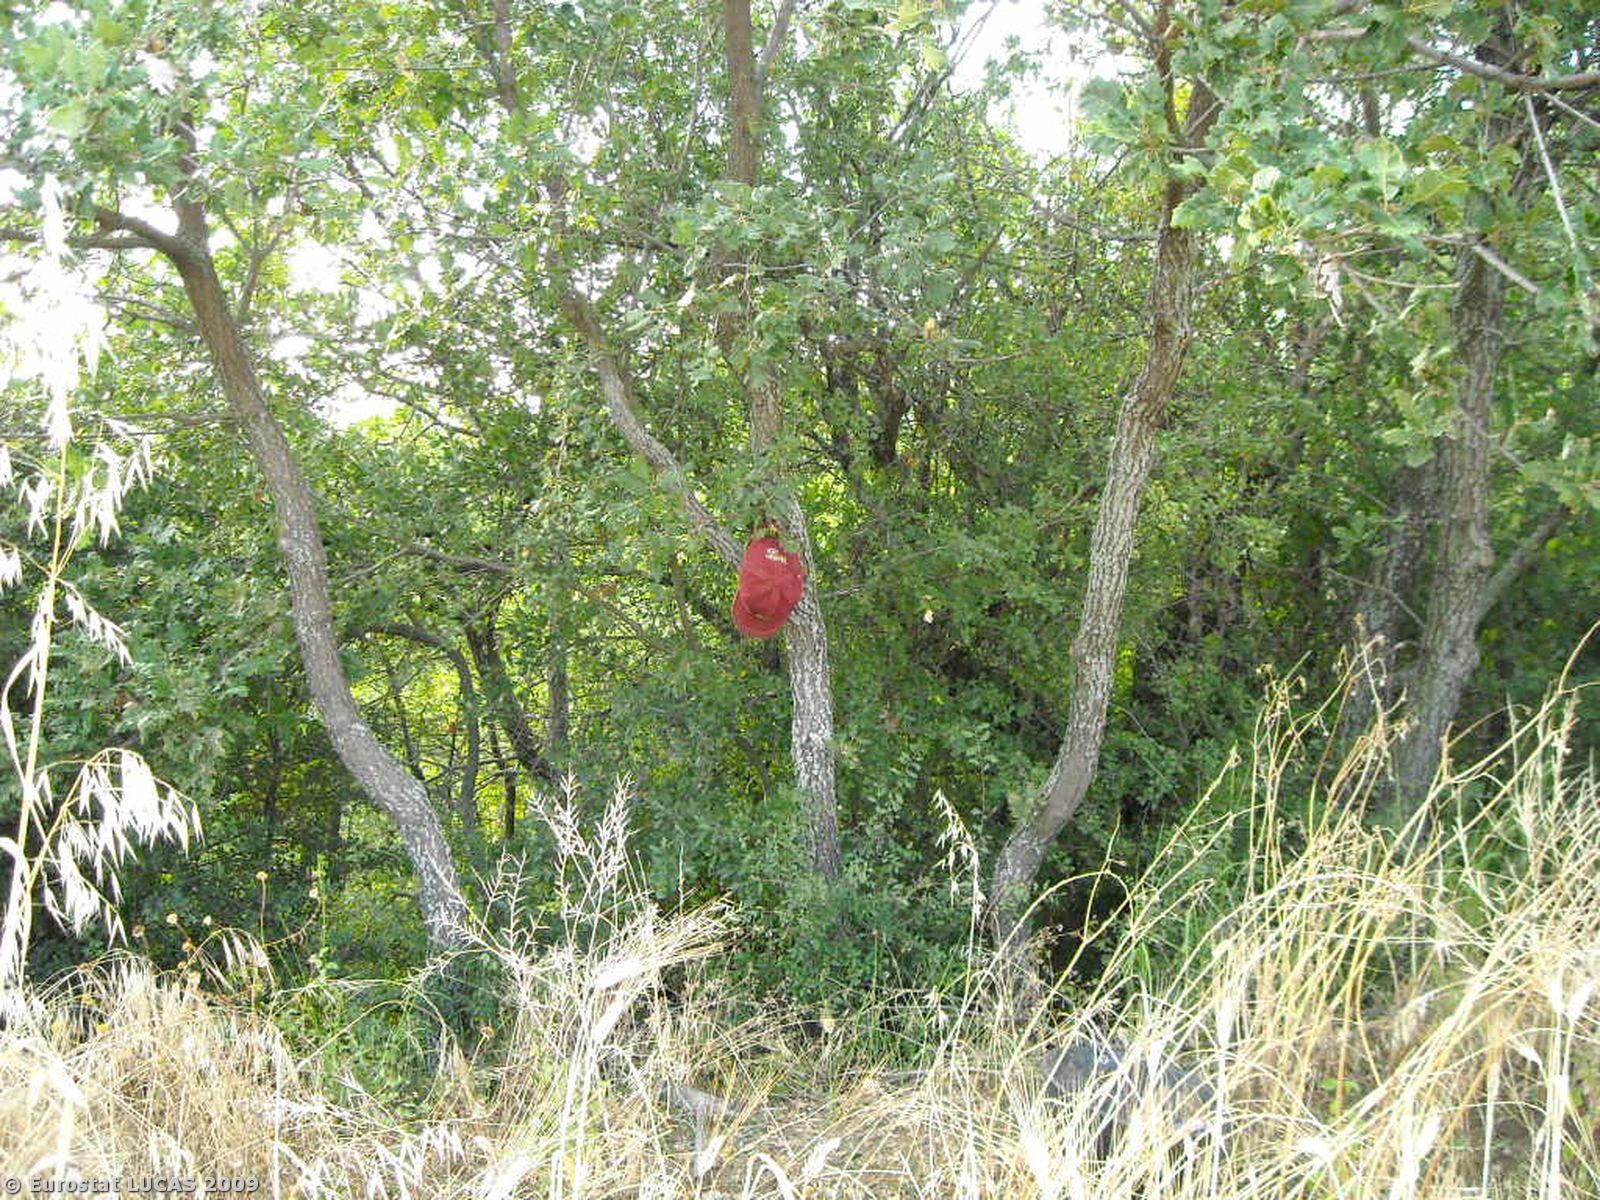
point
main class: Woodland
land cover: Broadleaved woodland
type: thermophilous deciduous forest
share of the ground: > 75 %
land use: Agriculture (excluding fallow land and kitchen gardens)
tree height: > 5 m
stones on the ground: < 10 %
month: July
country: IT
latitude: 40.6555
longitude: 16.1392
